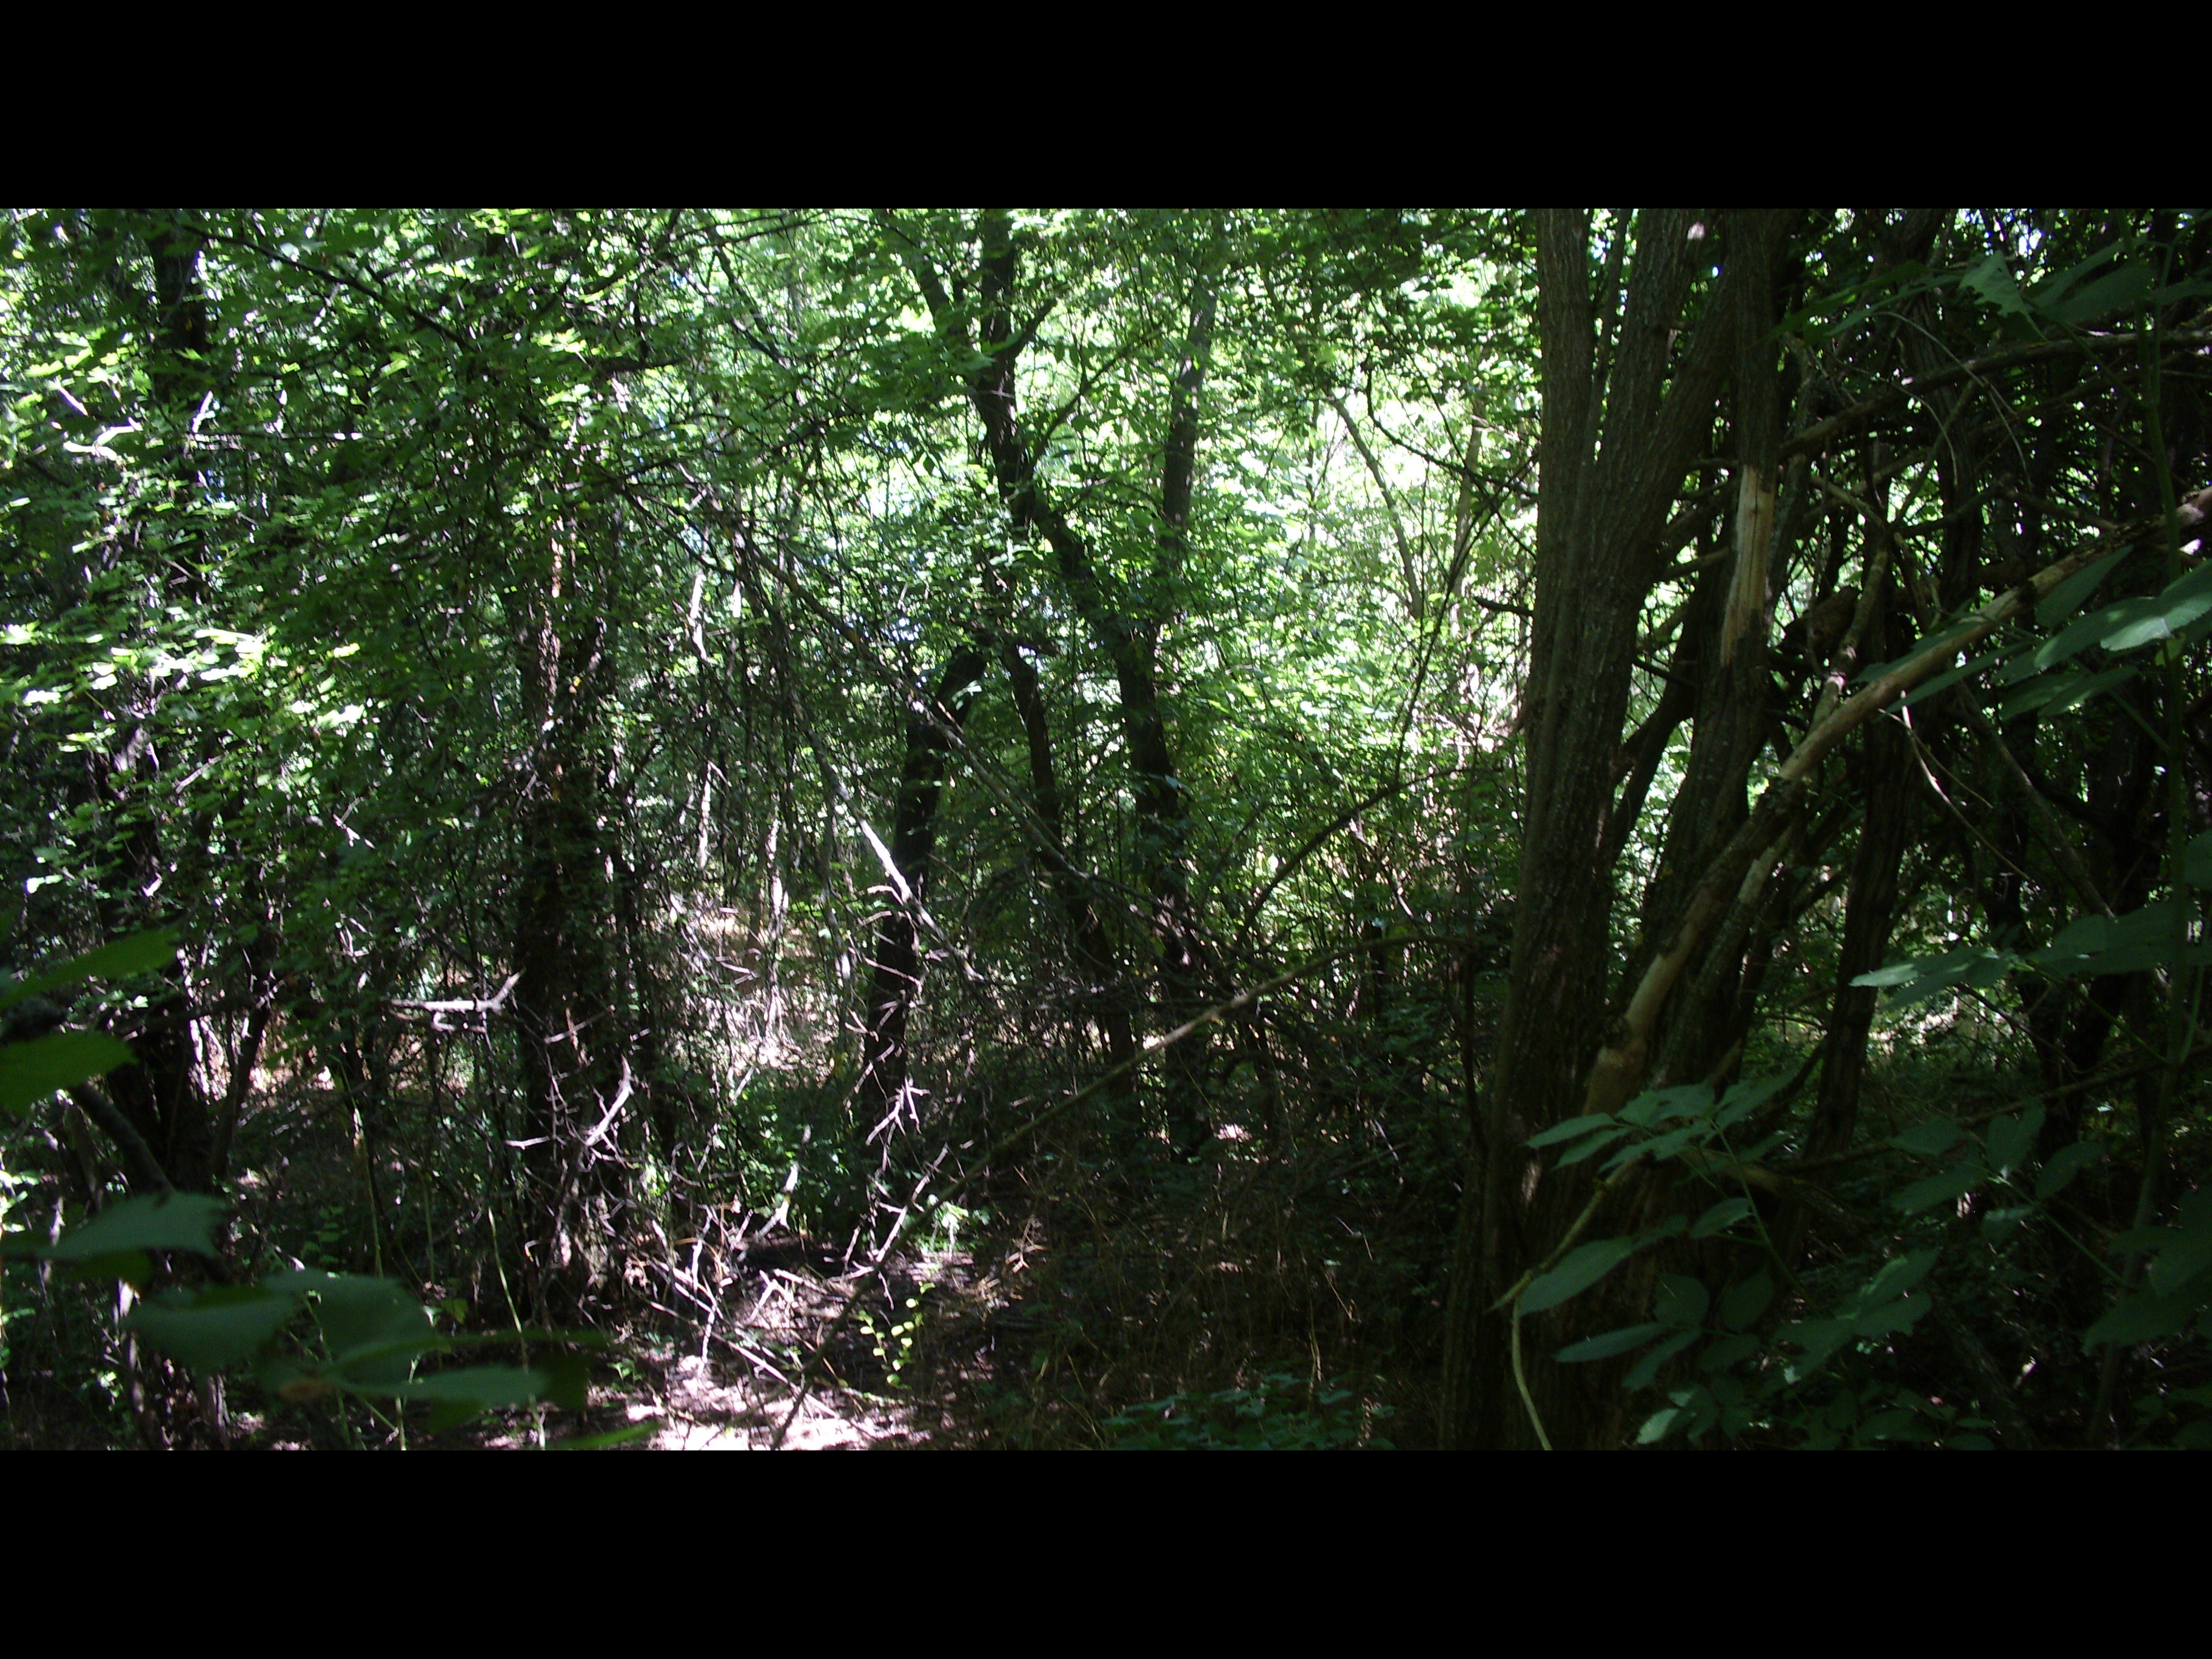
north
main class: Woodland
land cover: Broadleaved woodland
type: mesophytic deciduous forest
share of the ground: > 75 %
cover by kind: broadleaved forest trees 95 %, shrubs 5 %
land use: Forestry
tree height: > 5 m
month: June
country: BG
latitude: 43.6207
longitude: 23.6926
